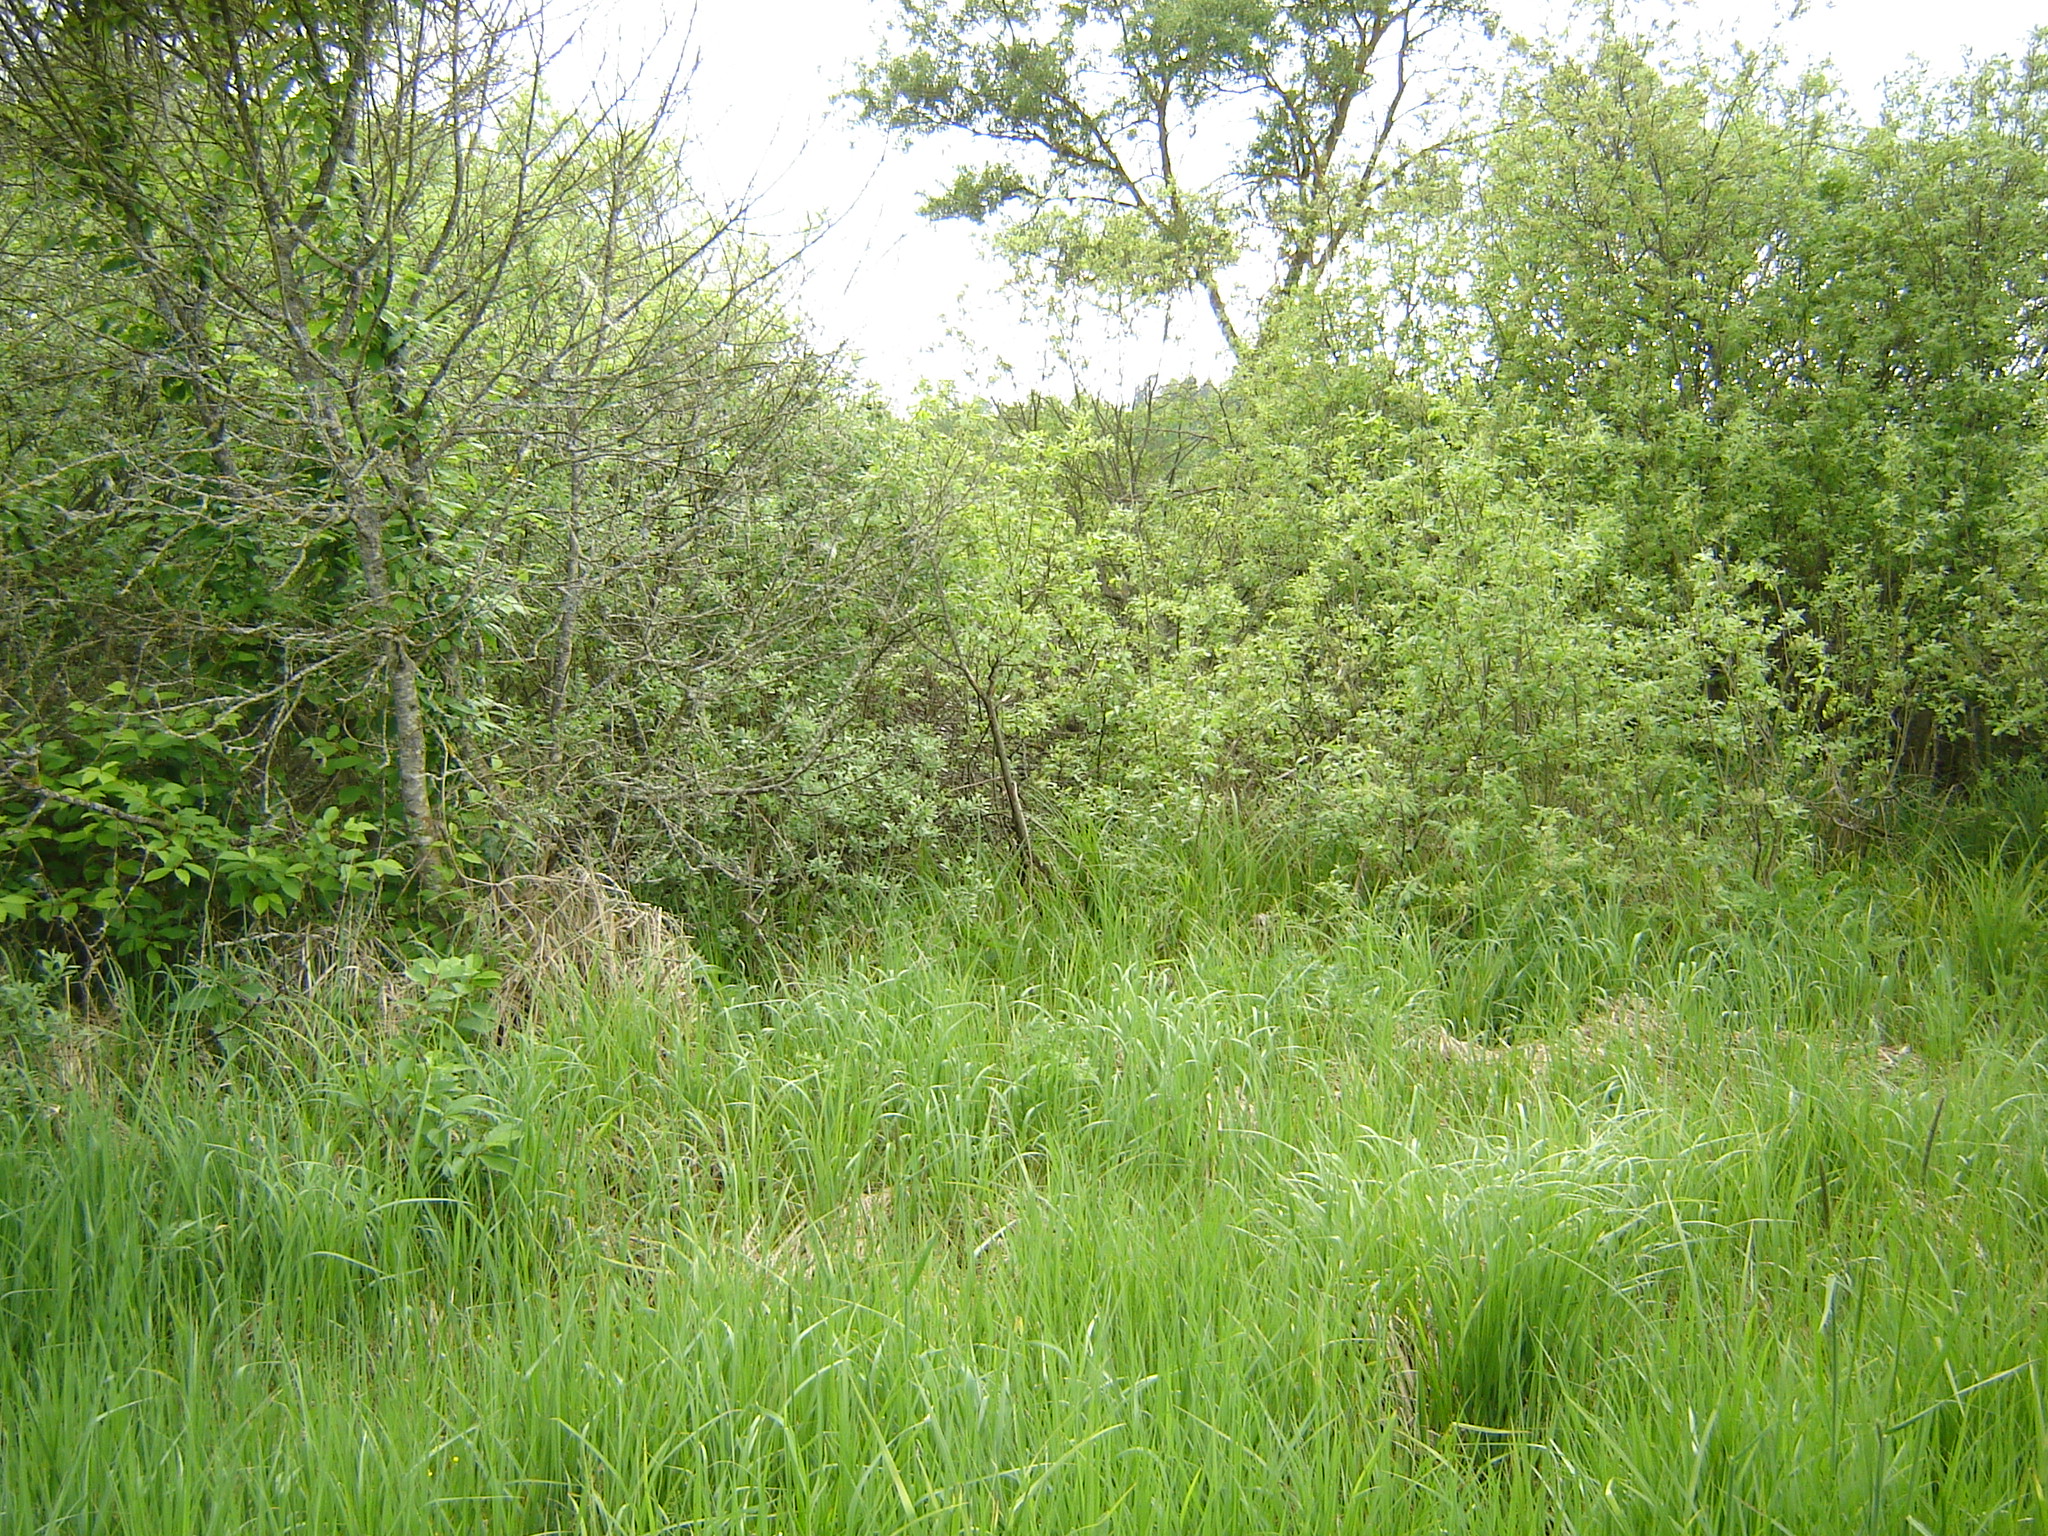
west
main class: Grassland
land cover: Grassland with sparse tree/shrub cover
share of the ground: > 75 %
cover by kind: herbaceous plants 95 %, broadleaved forest trees 5 %
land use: Semi-natural and natural areas not in use
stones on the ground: < 10 %
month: May
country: LT
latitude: 55.9980
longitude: 25.4331
